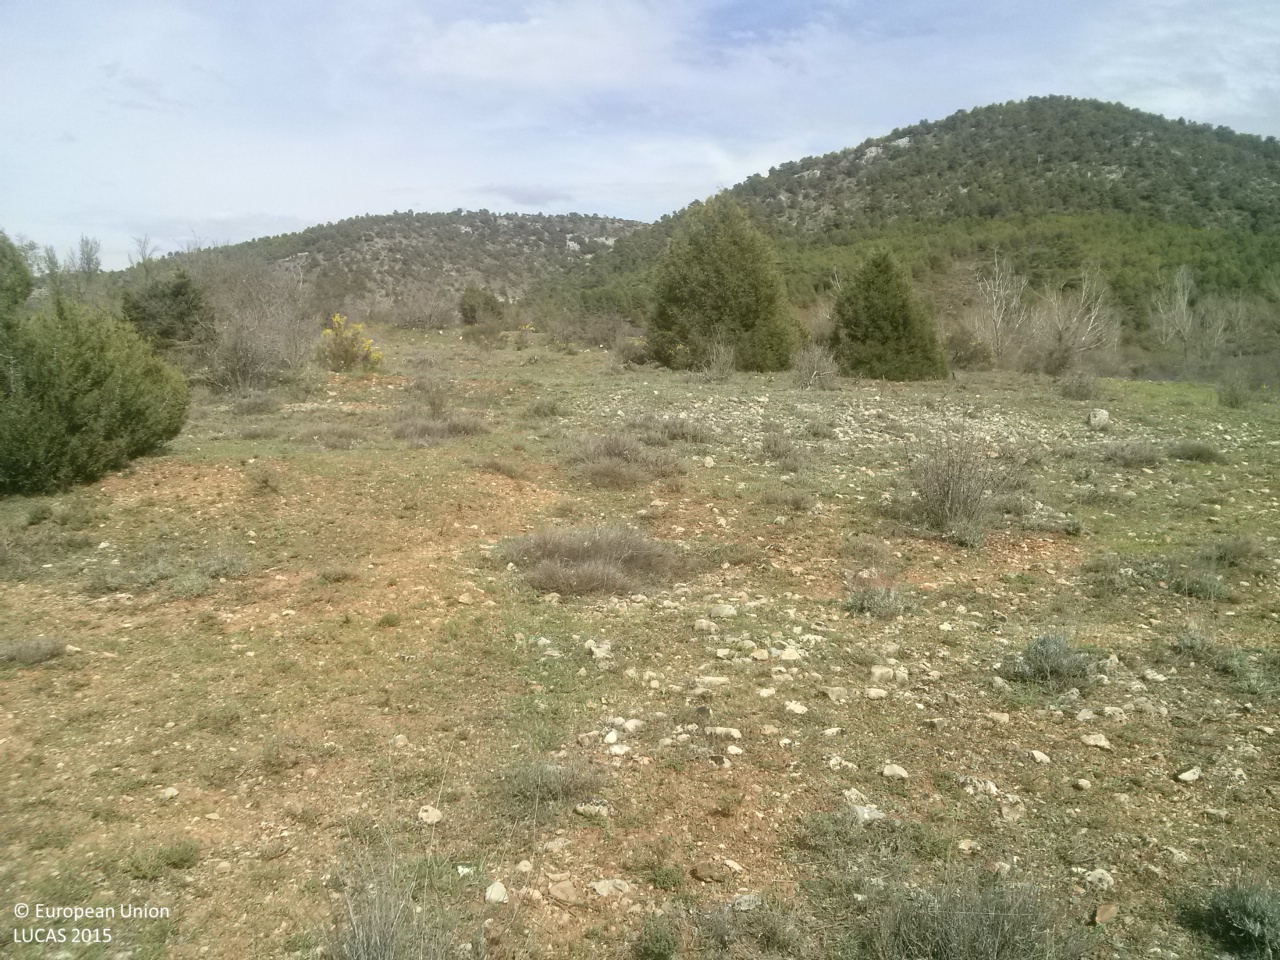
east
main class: Grassland
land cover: Grassland without tree/shrub cover
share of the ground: > 75 %
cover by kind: herbaceous plants 90 %, unconsolidated bare surface 10 %
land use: Agriculture (excluding fallow land and kitchen gardens)
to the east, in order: Grassland without tree/shrub cover; Grassland with sparse tree/shrub cover; Tracks; Shrubland without tree cover; Fences; Other bare soil; Fences; Grassland without tree/shrub cover
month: April
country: ES
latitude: 40.0852
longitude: -1.7759
